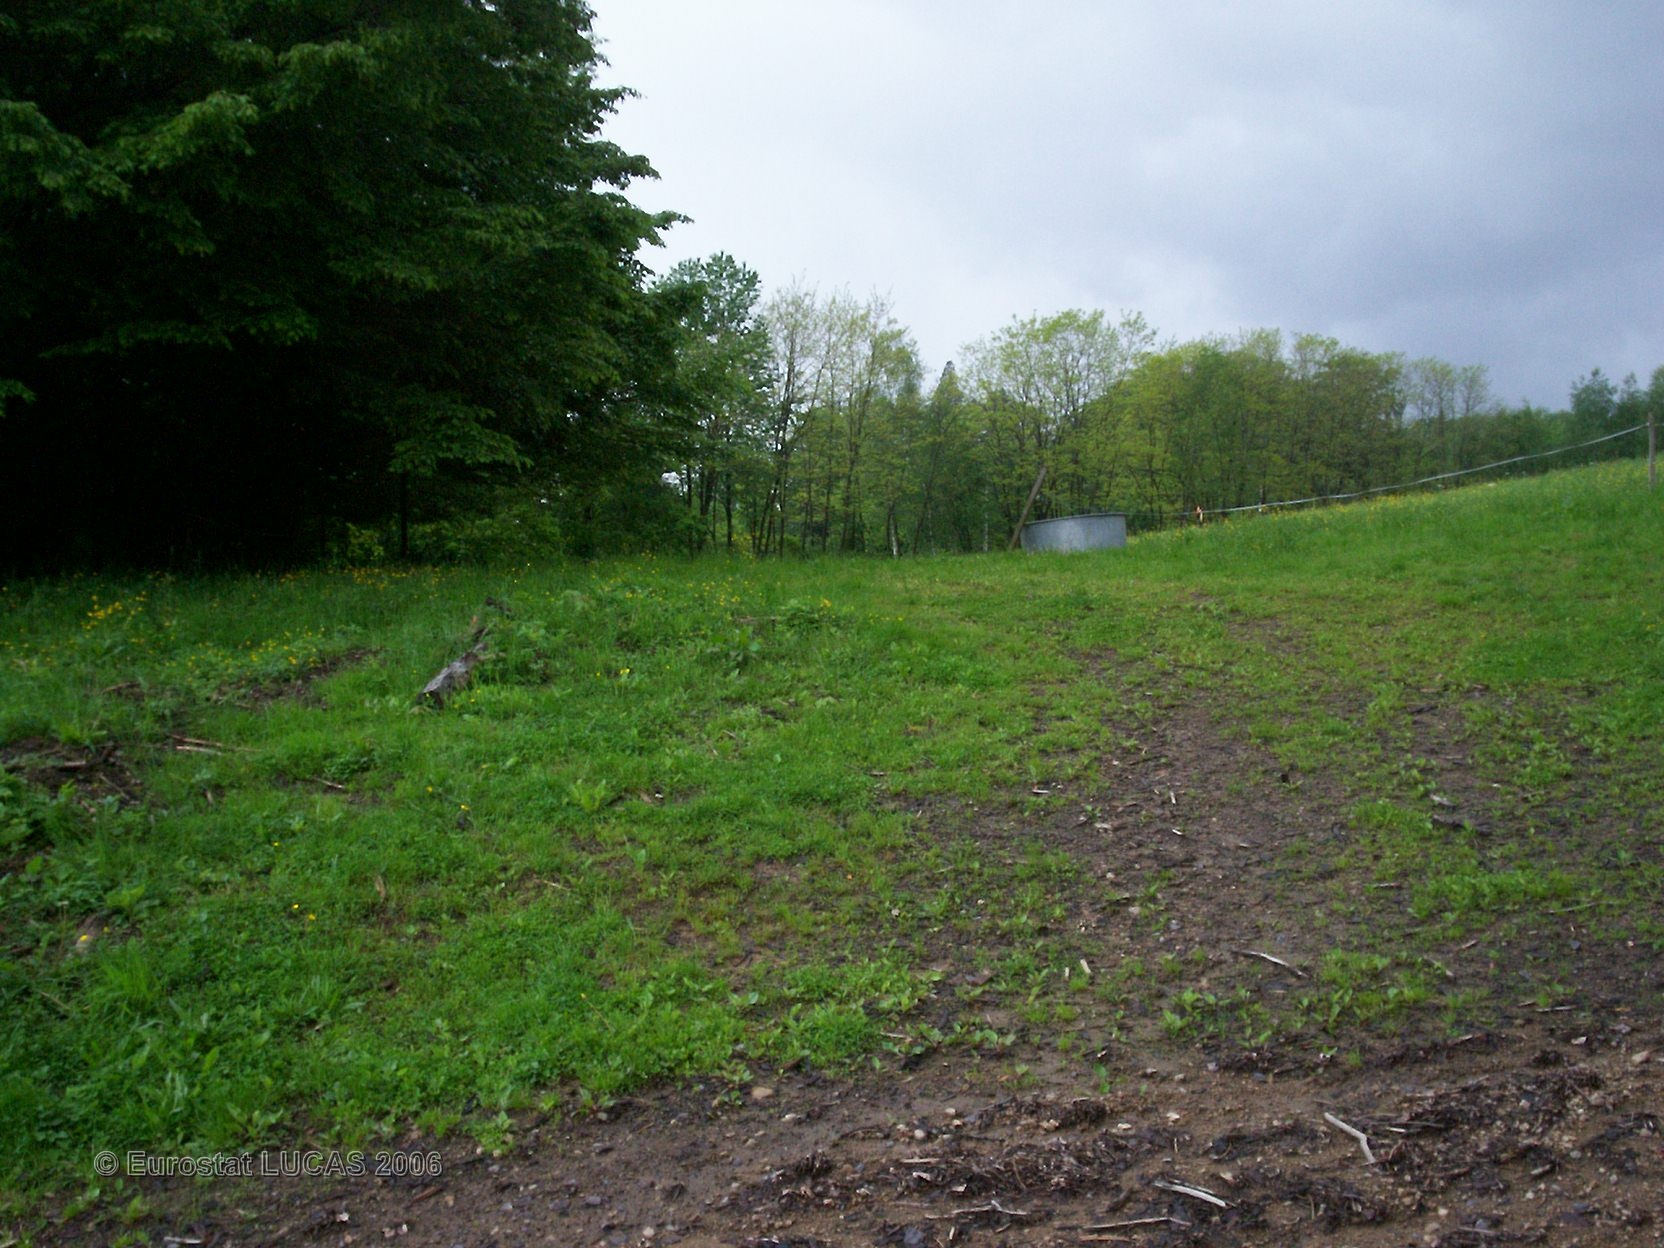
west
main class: Grassland
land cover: Grassland without tree/shrub cover
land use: Agriculture (excluding fallow land and kitchen gardens)
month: May
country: FR
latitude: 48.2935
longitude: 7.1029
